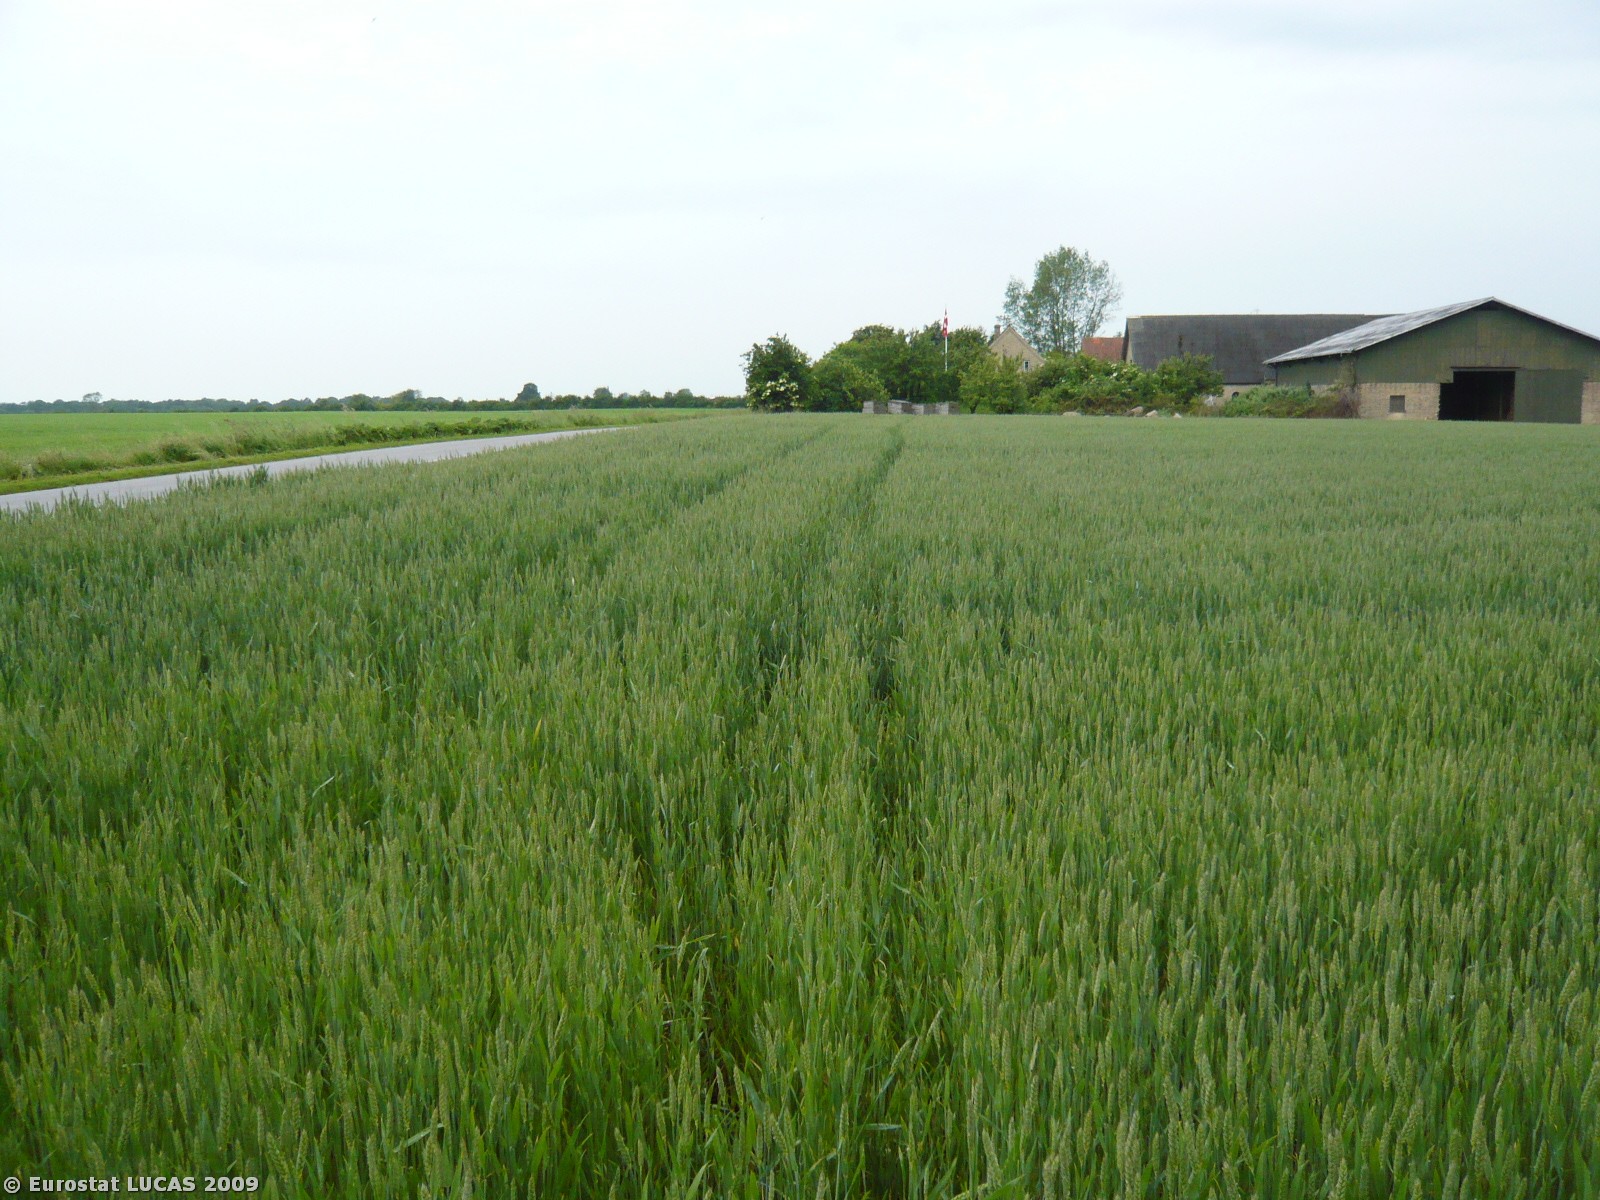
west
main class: Grassland
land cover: Grassland without tree/shrub cover
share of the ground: > 75 %
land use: Agriculture (excluding fallow land and kitchen gardens)
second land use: Road transport
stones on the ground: < 10 %
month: June
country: DK
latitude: 54.7555
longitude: 11.7547
